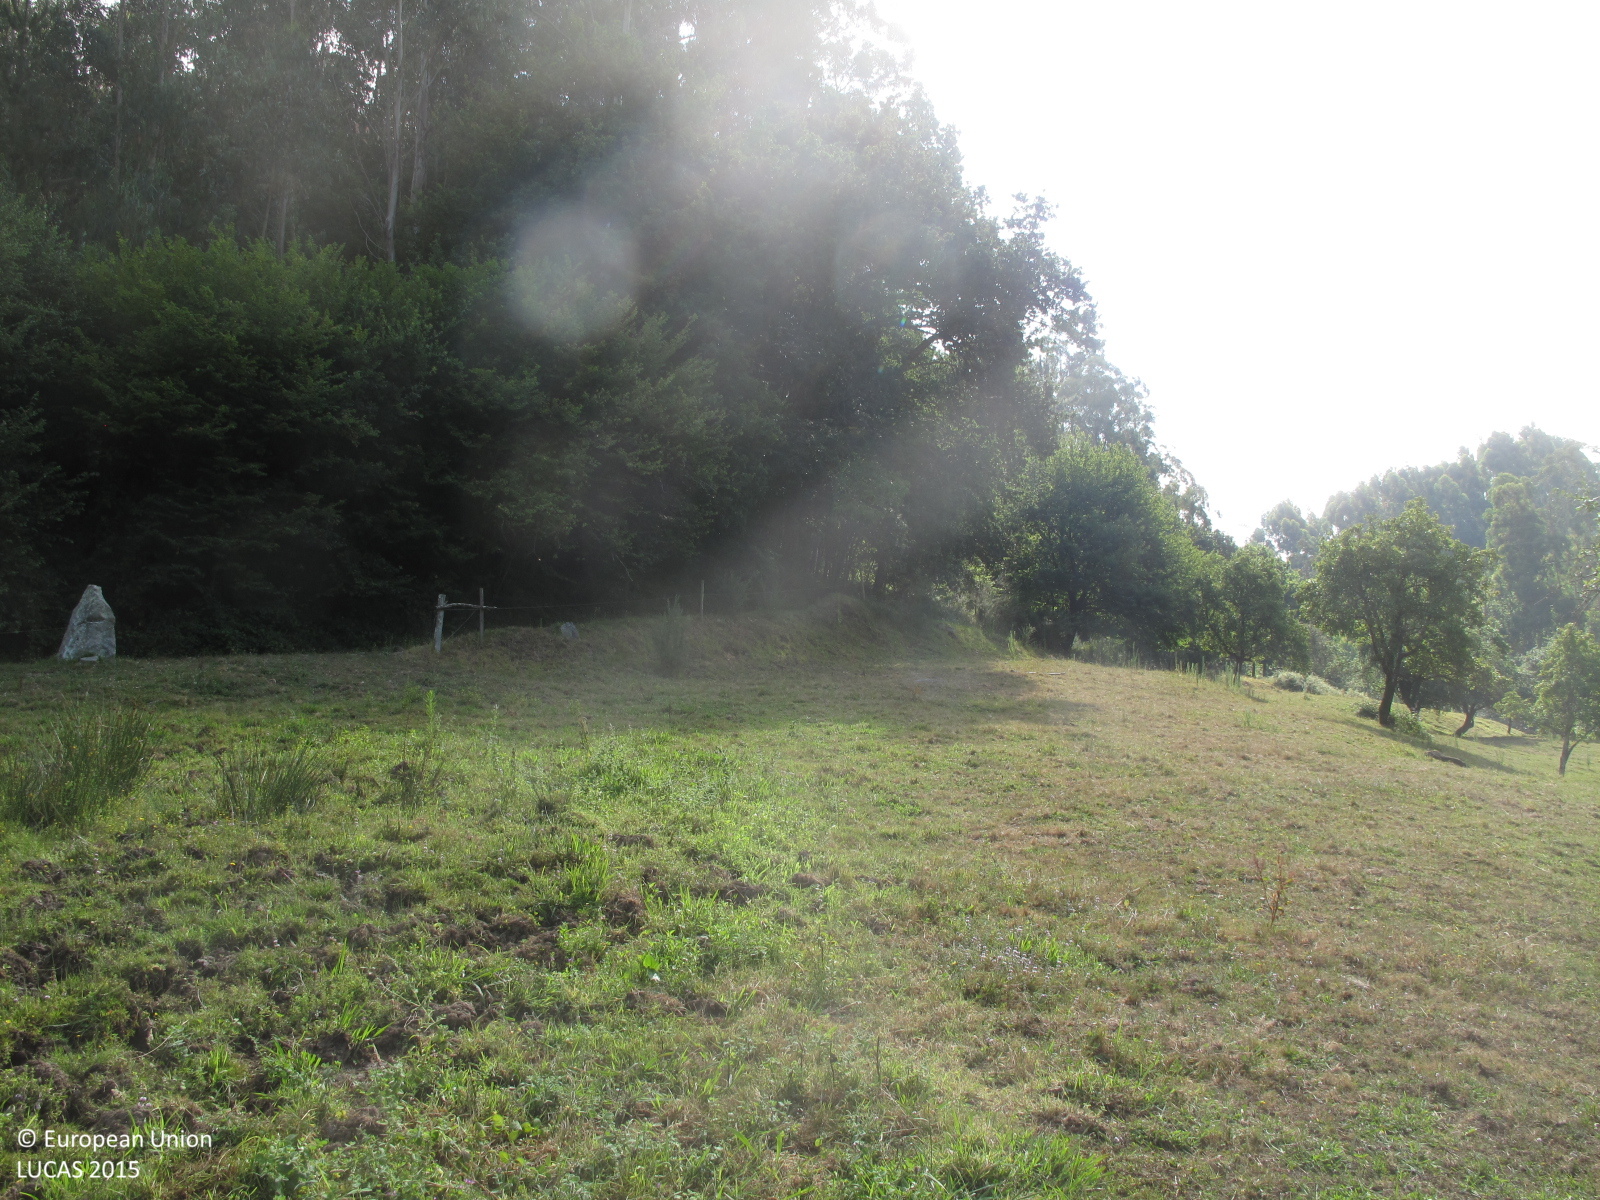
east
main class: Grassland
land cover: Grassland with sparse tree/shrub cover
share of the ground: > 75 %
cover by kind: herbaceous plants 95 %, broadleaved forest trees 5 %
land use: Agriculture (excluding fallow land and kitchen gardens)
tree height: < 5 m
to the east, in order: Grassland with sparse tree/shrub cover; Other mixed woodland; Shrubland with sparse tree cover; Electric lines; Shrubland with sparse tree cover; Other mixed woodland; Broadleaved woodland; Tracks
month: July
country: ES
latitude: 43.3082
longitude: -8.1344
